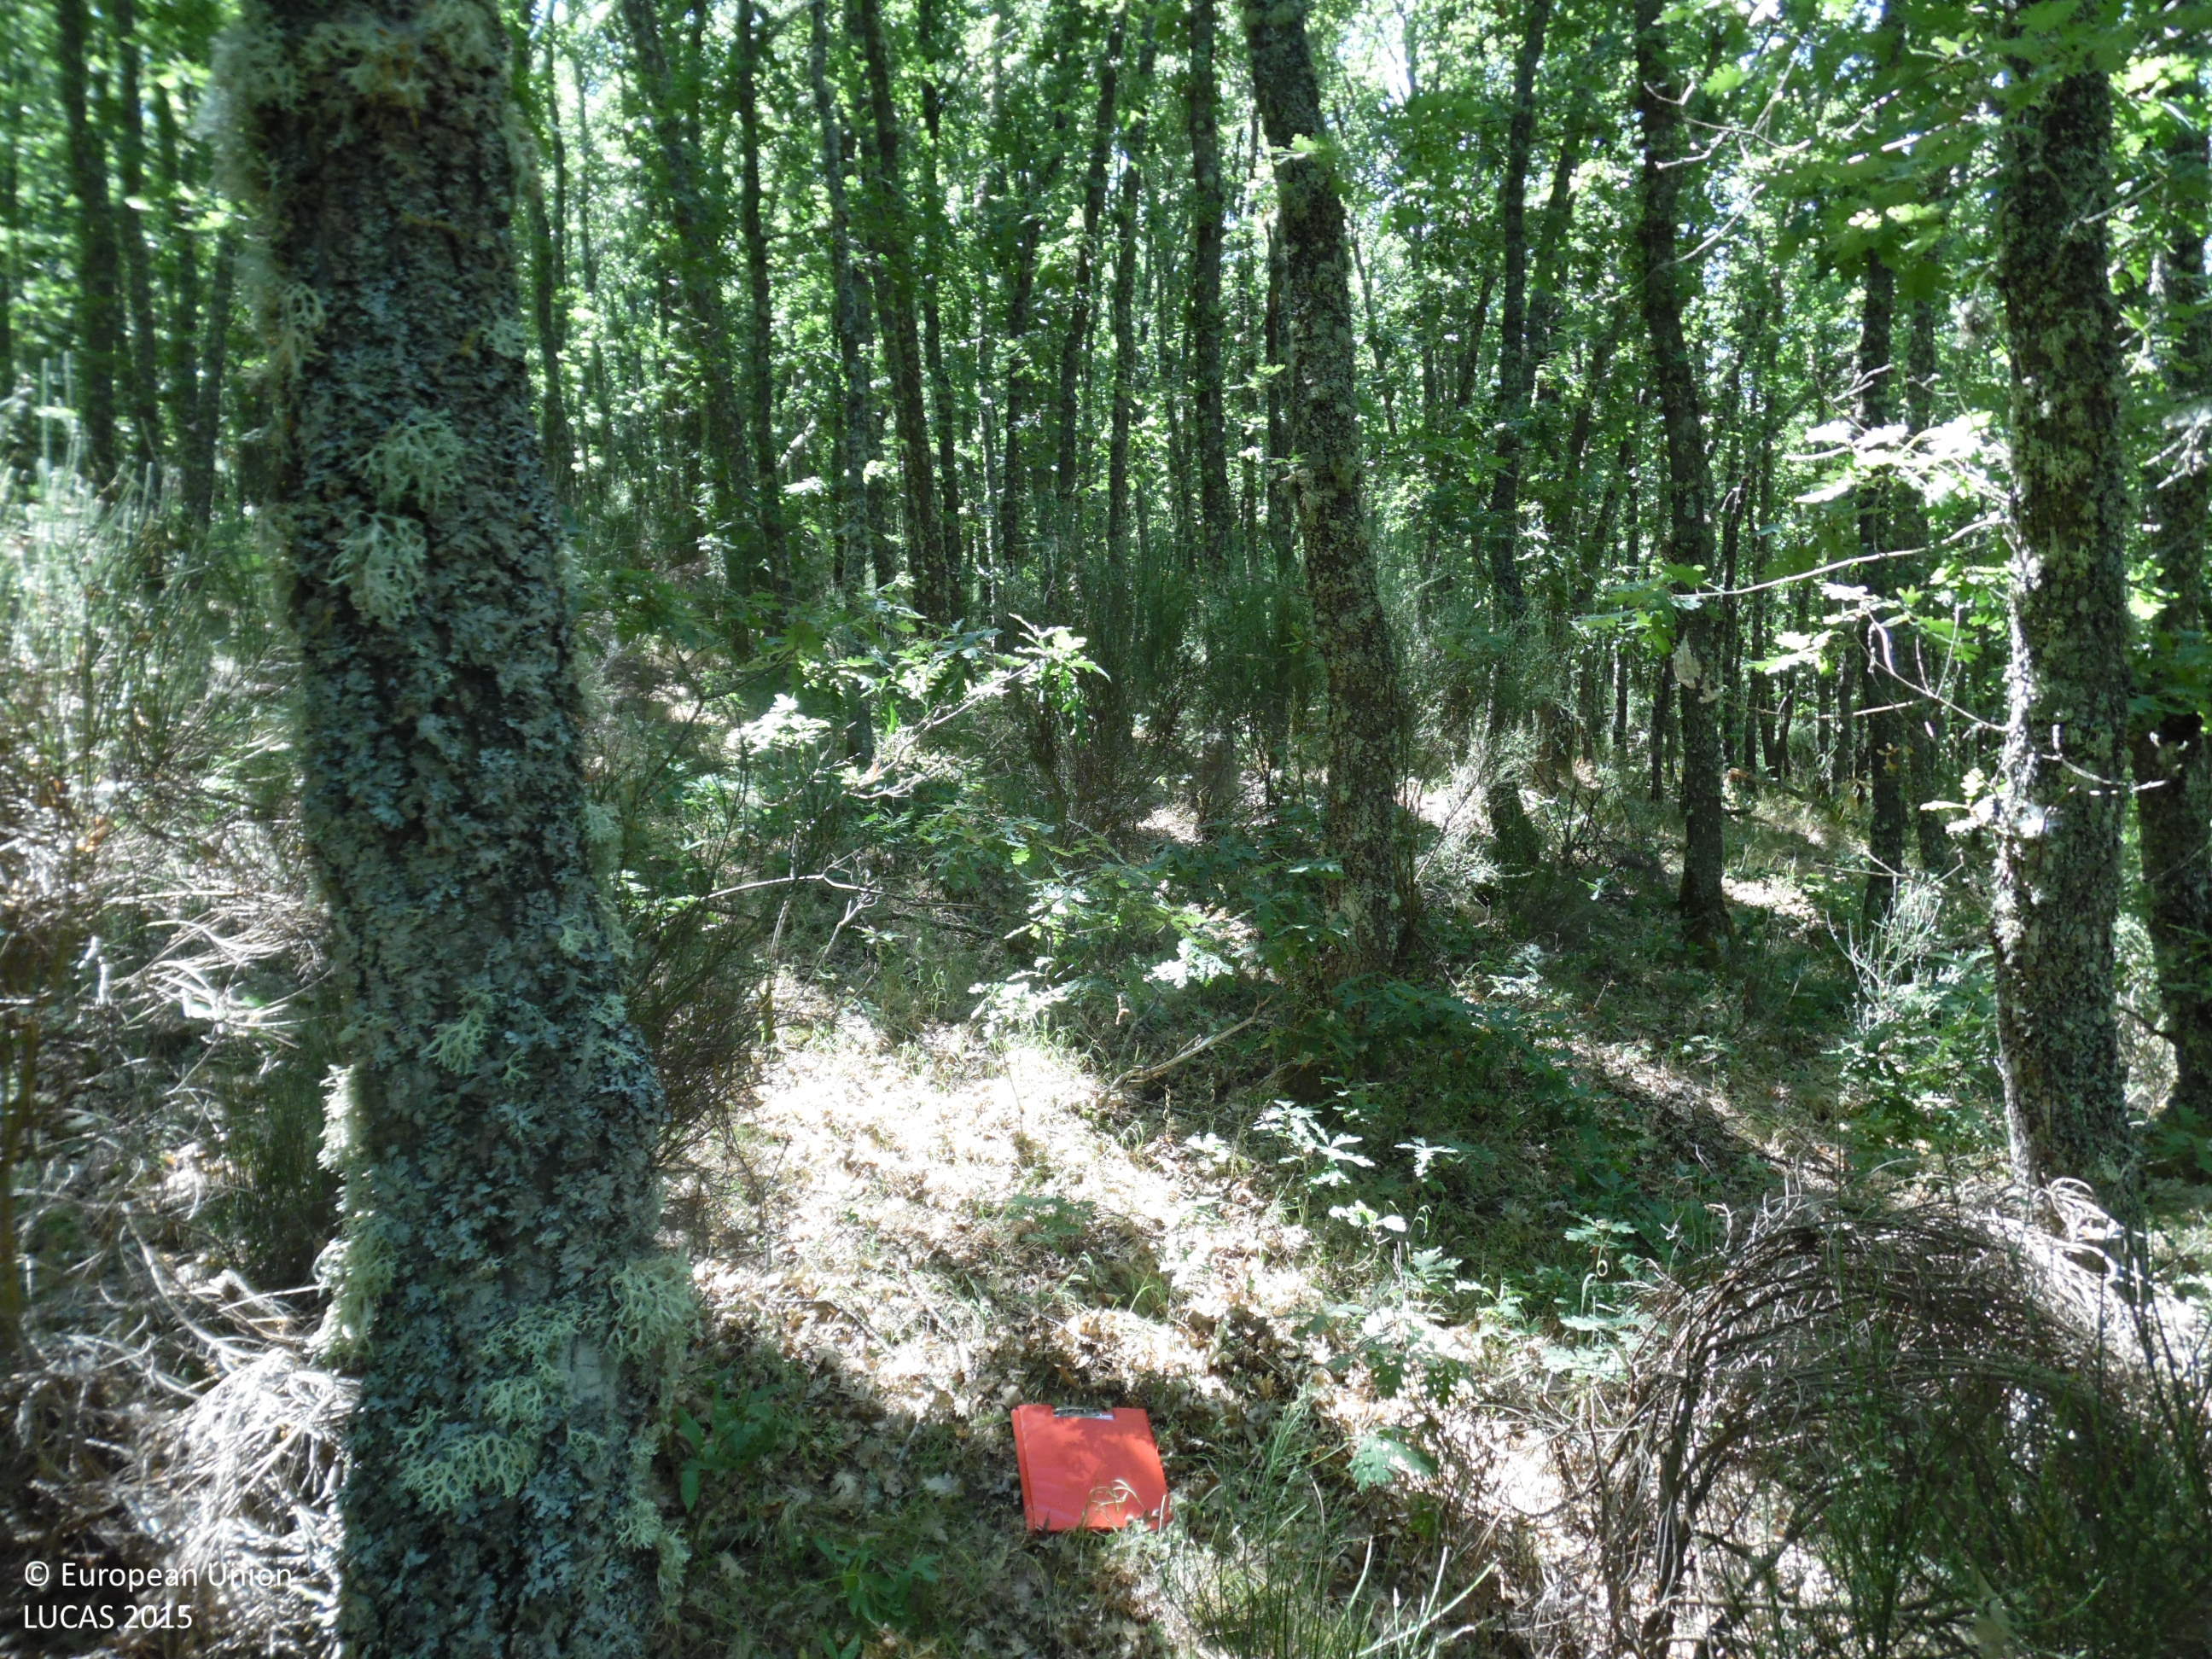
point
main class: Woodland
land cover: Broadleaved woodland
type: thermophilous deciduous forest
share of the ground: > 75 %
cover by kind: broadleaved forest trees 100 %
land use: Forestry
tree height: > 5 m
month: July
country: ES
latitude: 42.7765
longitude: -5.8354
